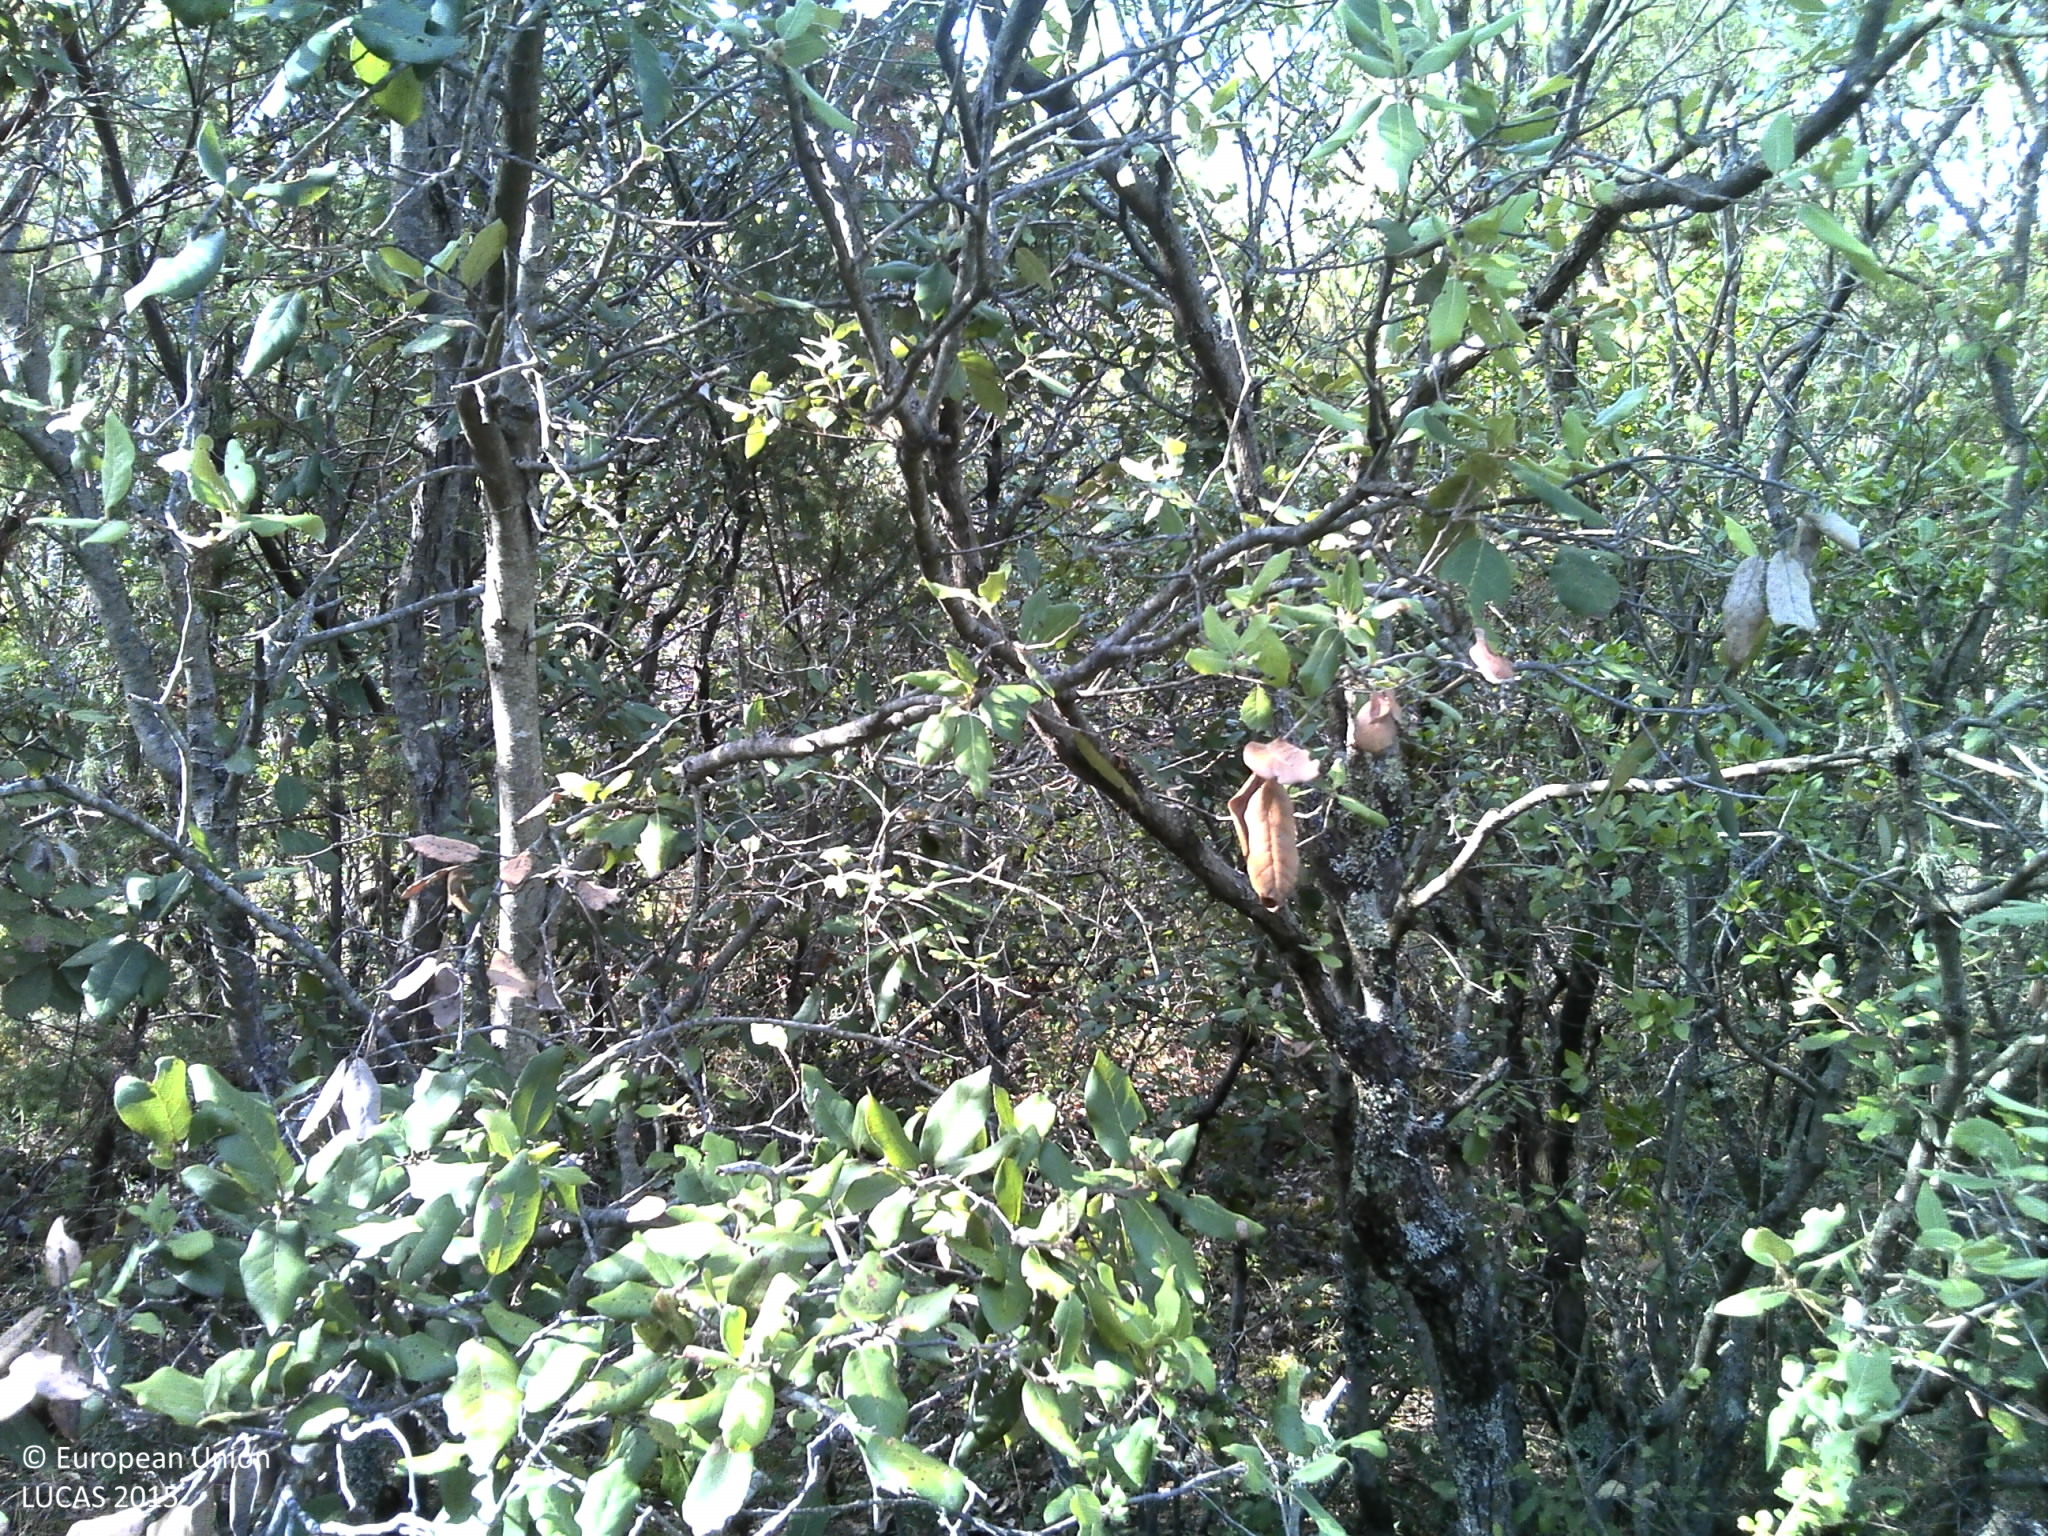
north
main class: Shrubland
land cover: Shrubland with sparse tree cover
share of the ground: > 75 %
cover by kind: shrubs 75 %, broadleaved forest trees 5 %, herbaceous plants 5 %, lichens and mosses 5 %, consolidated bare surface 5 %, unconsolidated bare surface 5 %
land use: Semi-natural and natural areas not in use
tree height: < 5 m
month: August
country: HR
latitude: 43.1390
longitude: 16.9609
